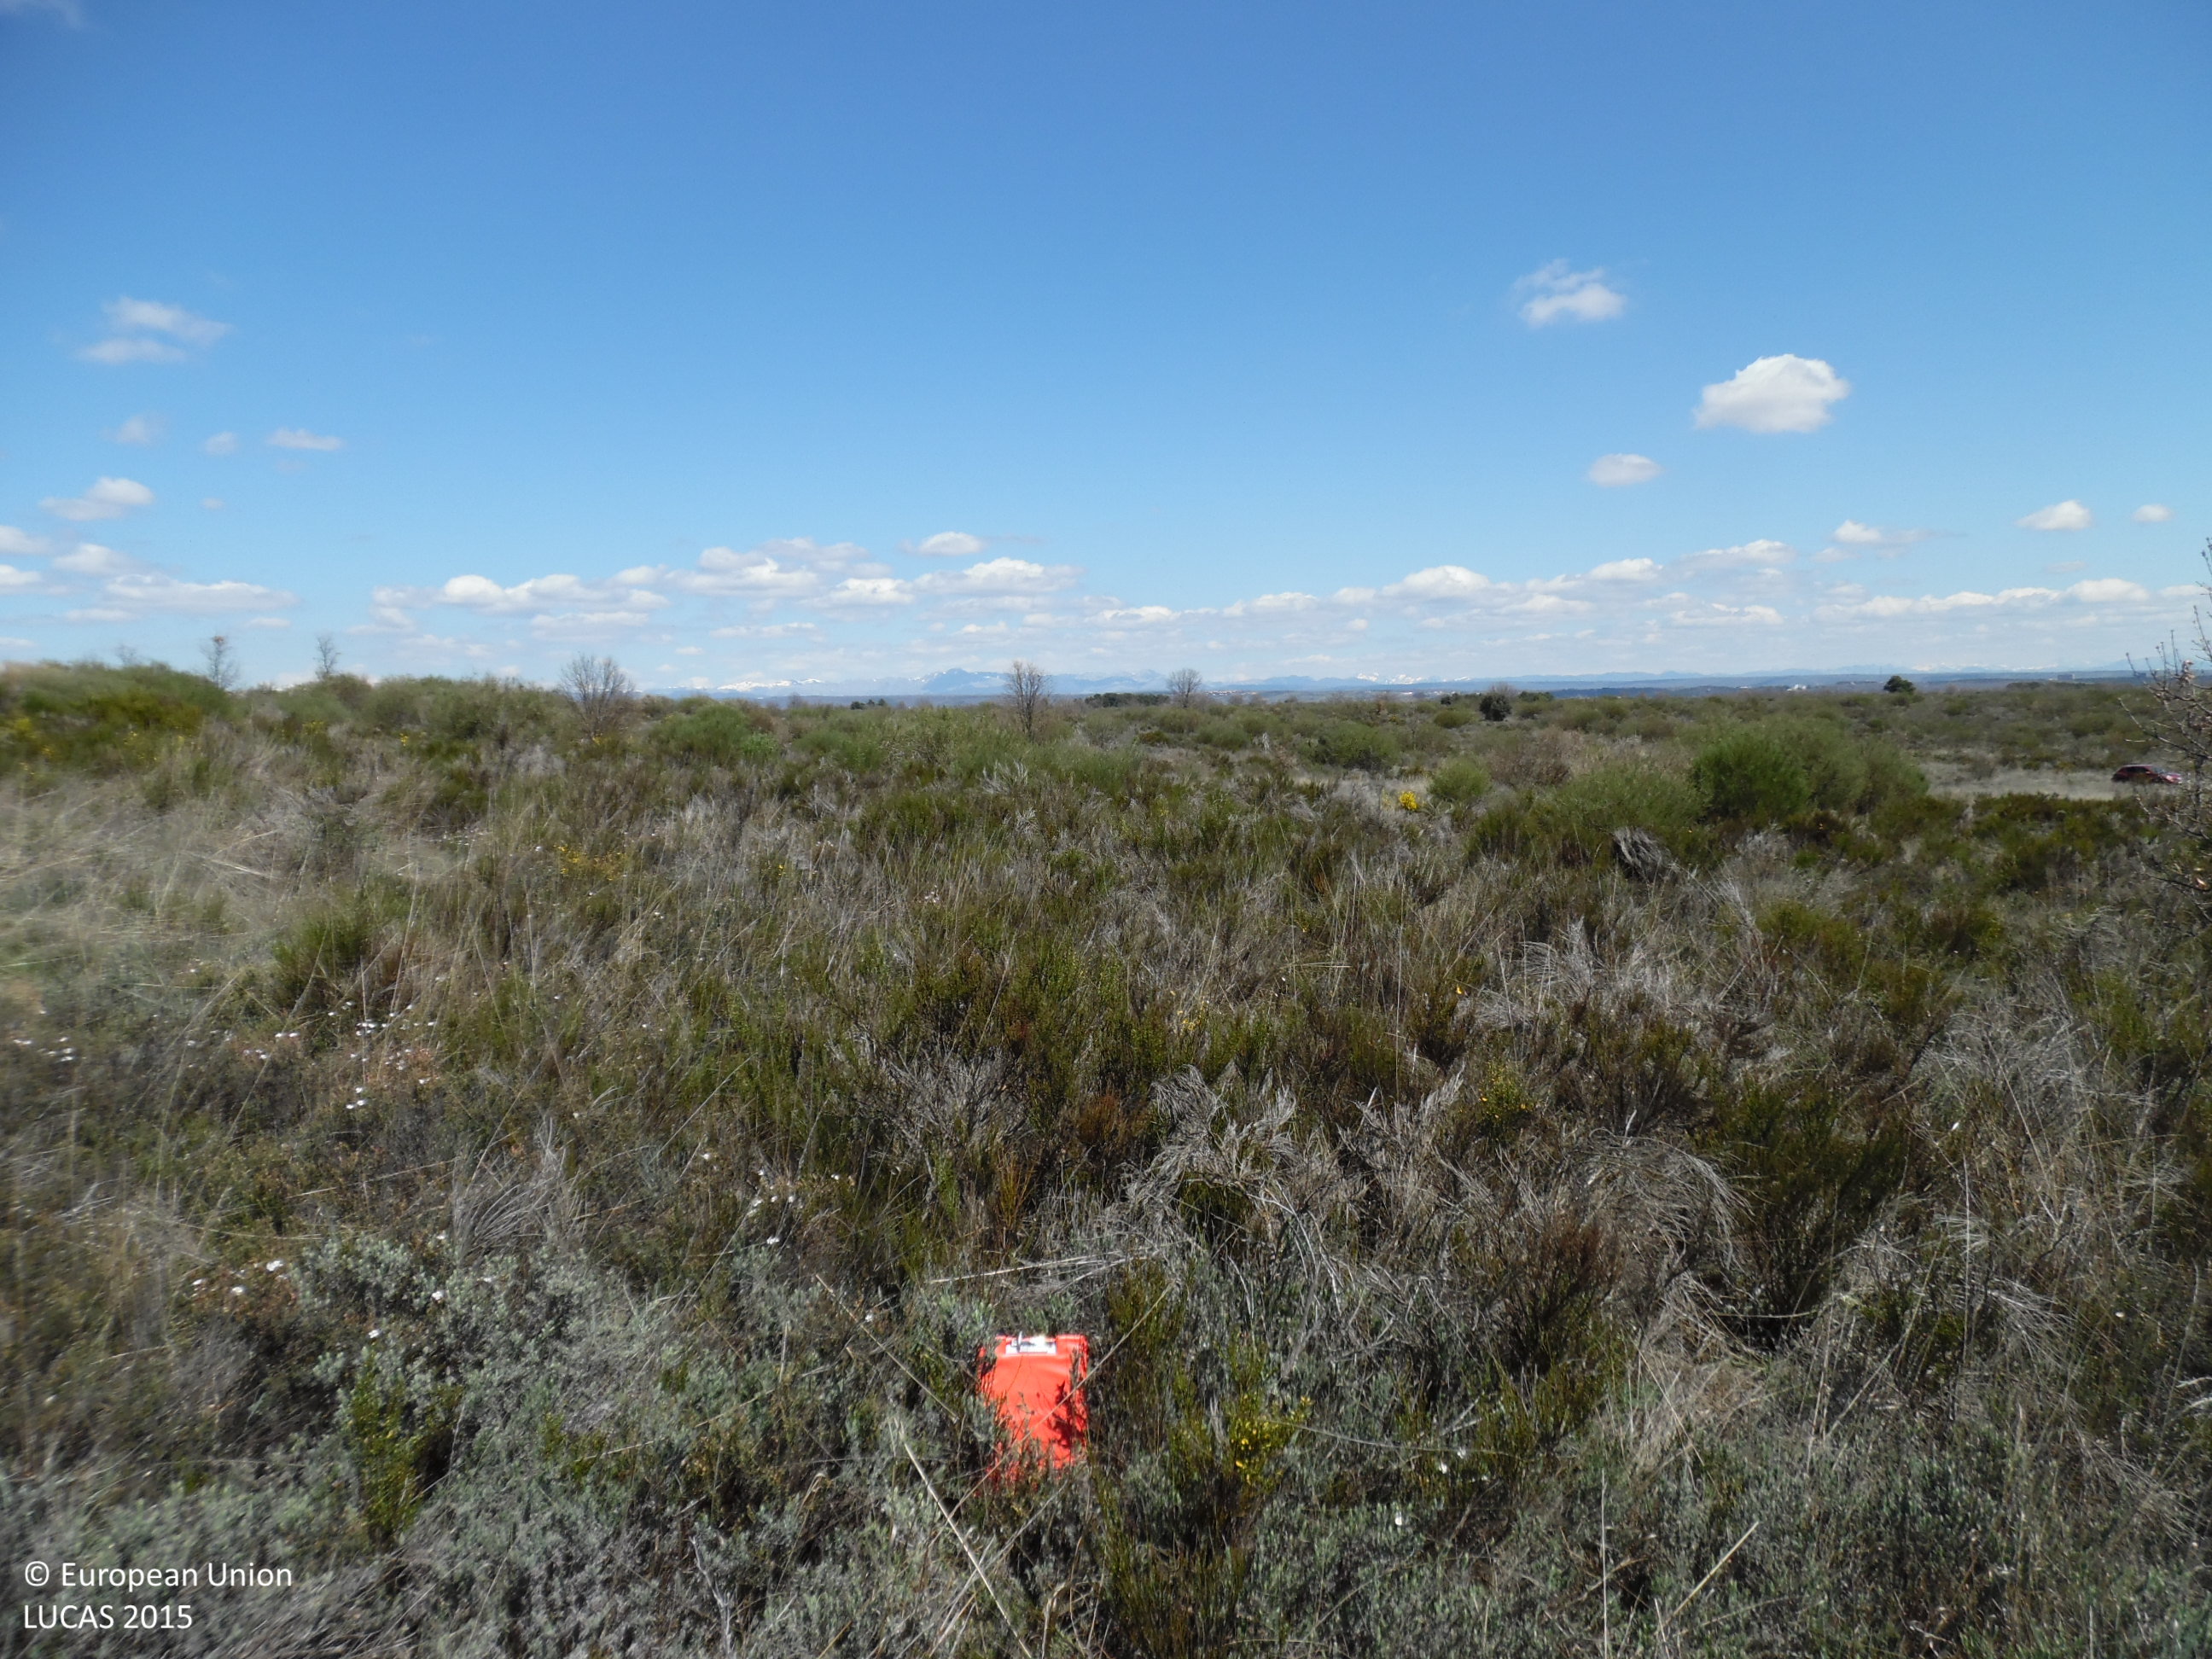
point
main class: Shrubland
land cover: Shrubland without tree cover
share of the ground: > 75 %
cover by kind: shrubs 95 %, herbaceous plants 5 %
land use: Abandoned areas
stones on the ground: 10 - 25 %
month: April
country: ES
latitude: 42.6016
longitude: -5.6636
